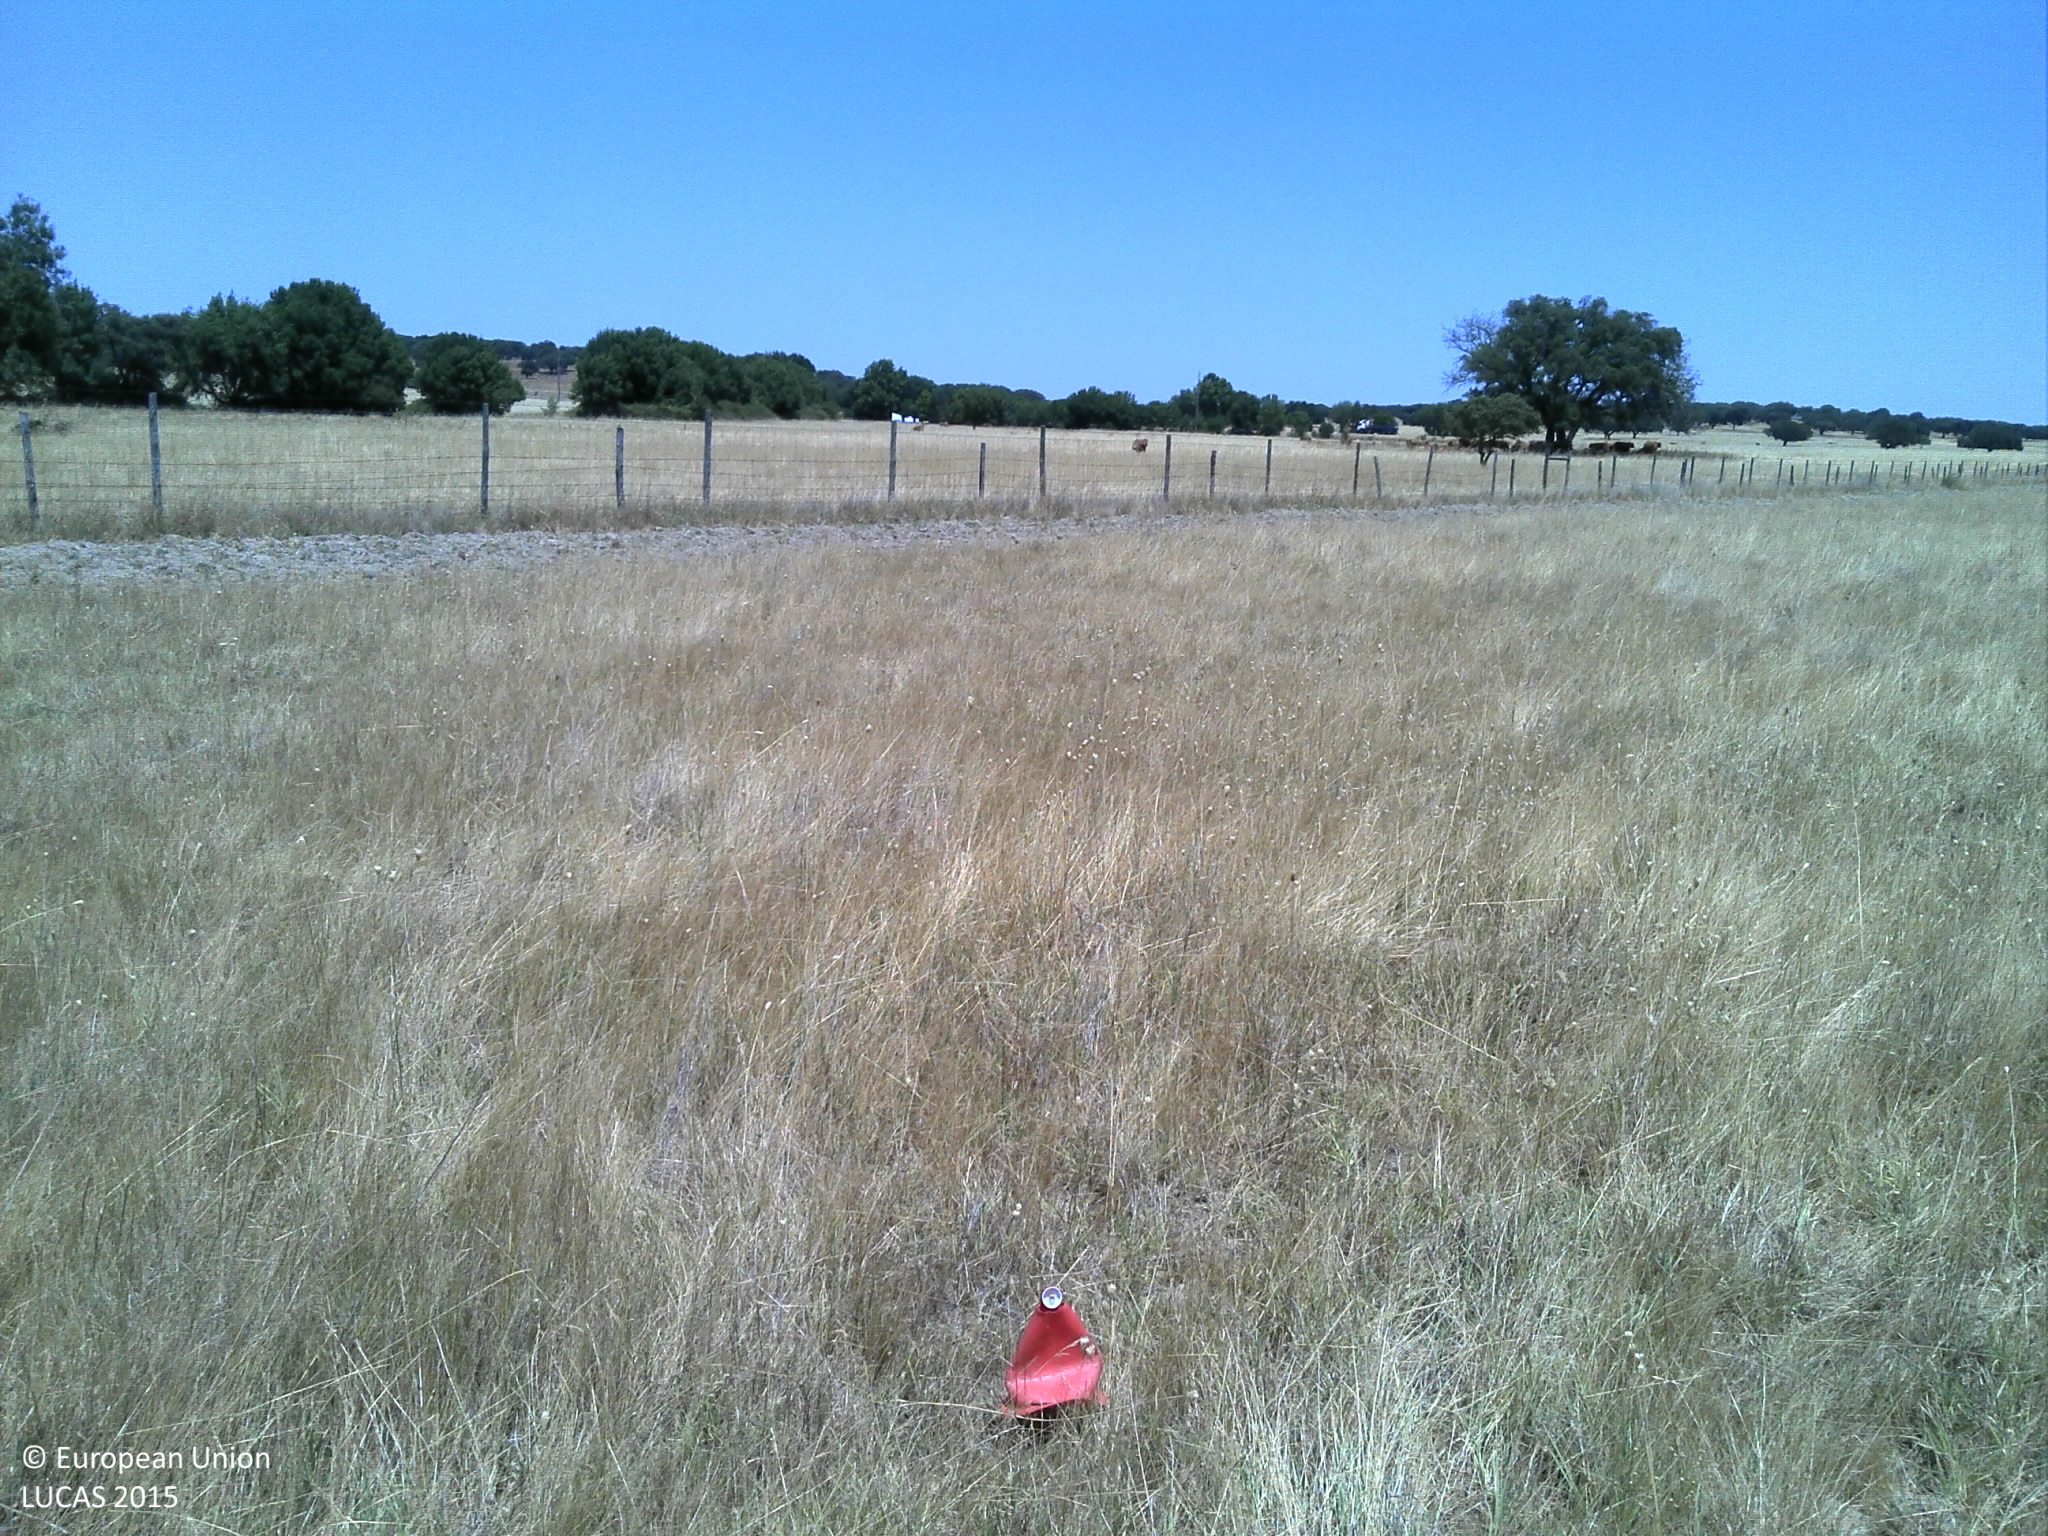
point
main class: Grassland
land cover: Grassland without tree/shrub cover
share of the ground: > 75 %
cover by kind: herbaceous plants 80 %, unconsolidated bare surface 20 %
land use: Agriculture (excluding fallow land and kitchen gardens)
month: June
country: PT
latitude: 38.4634
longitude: -8.1629
